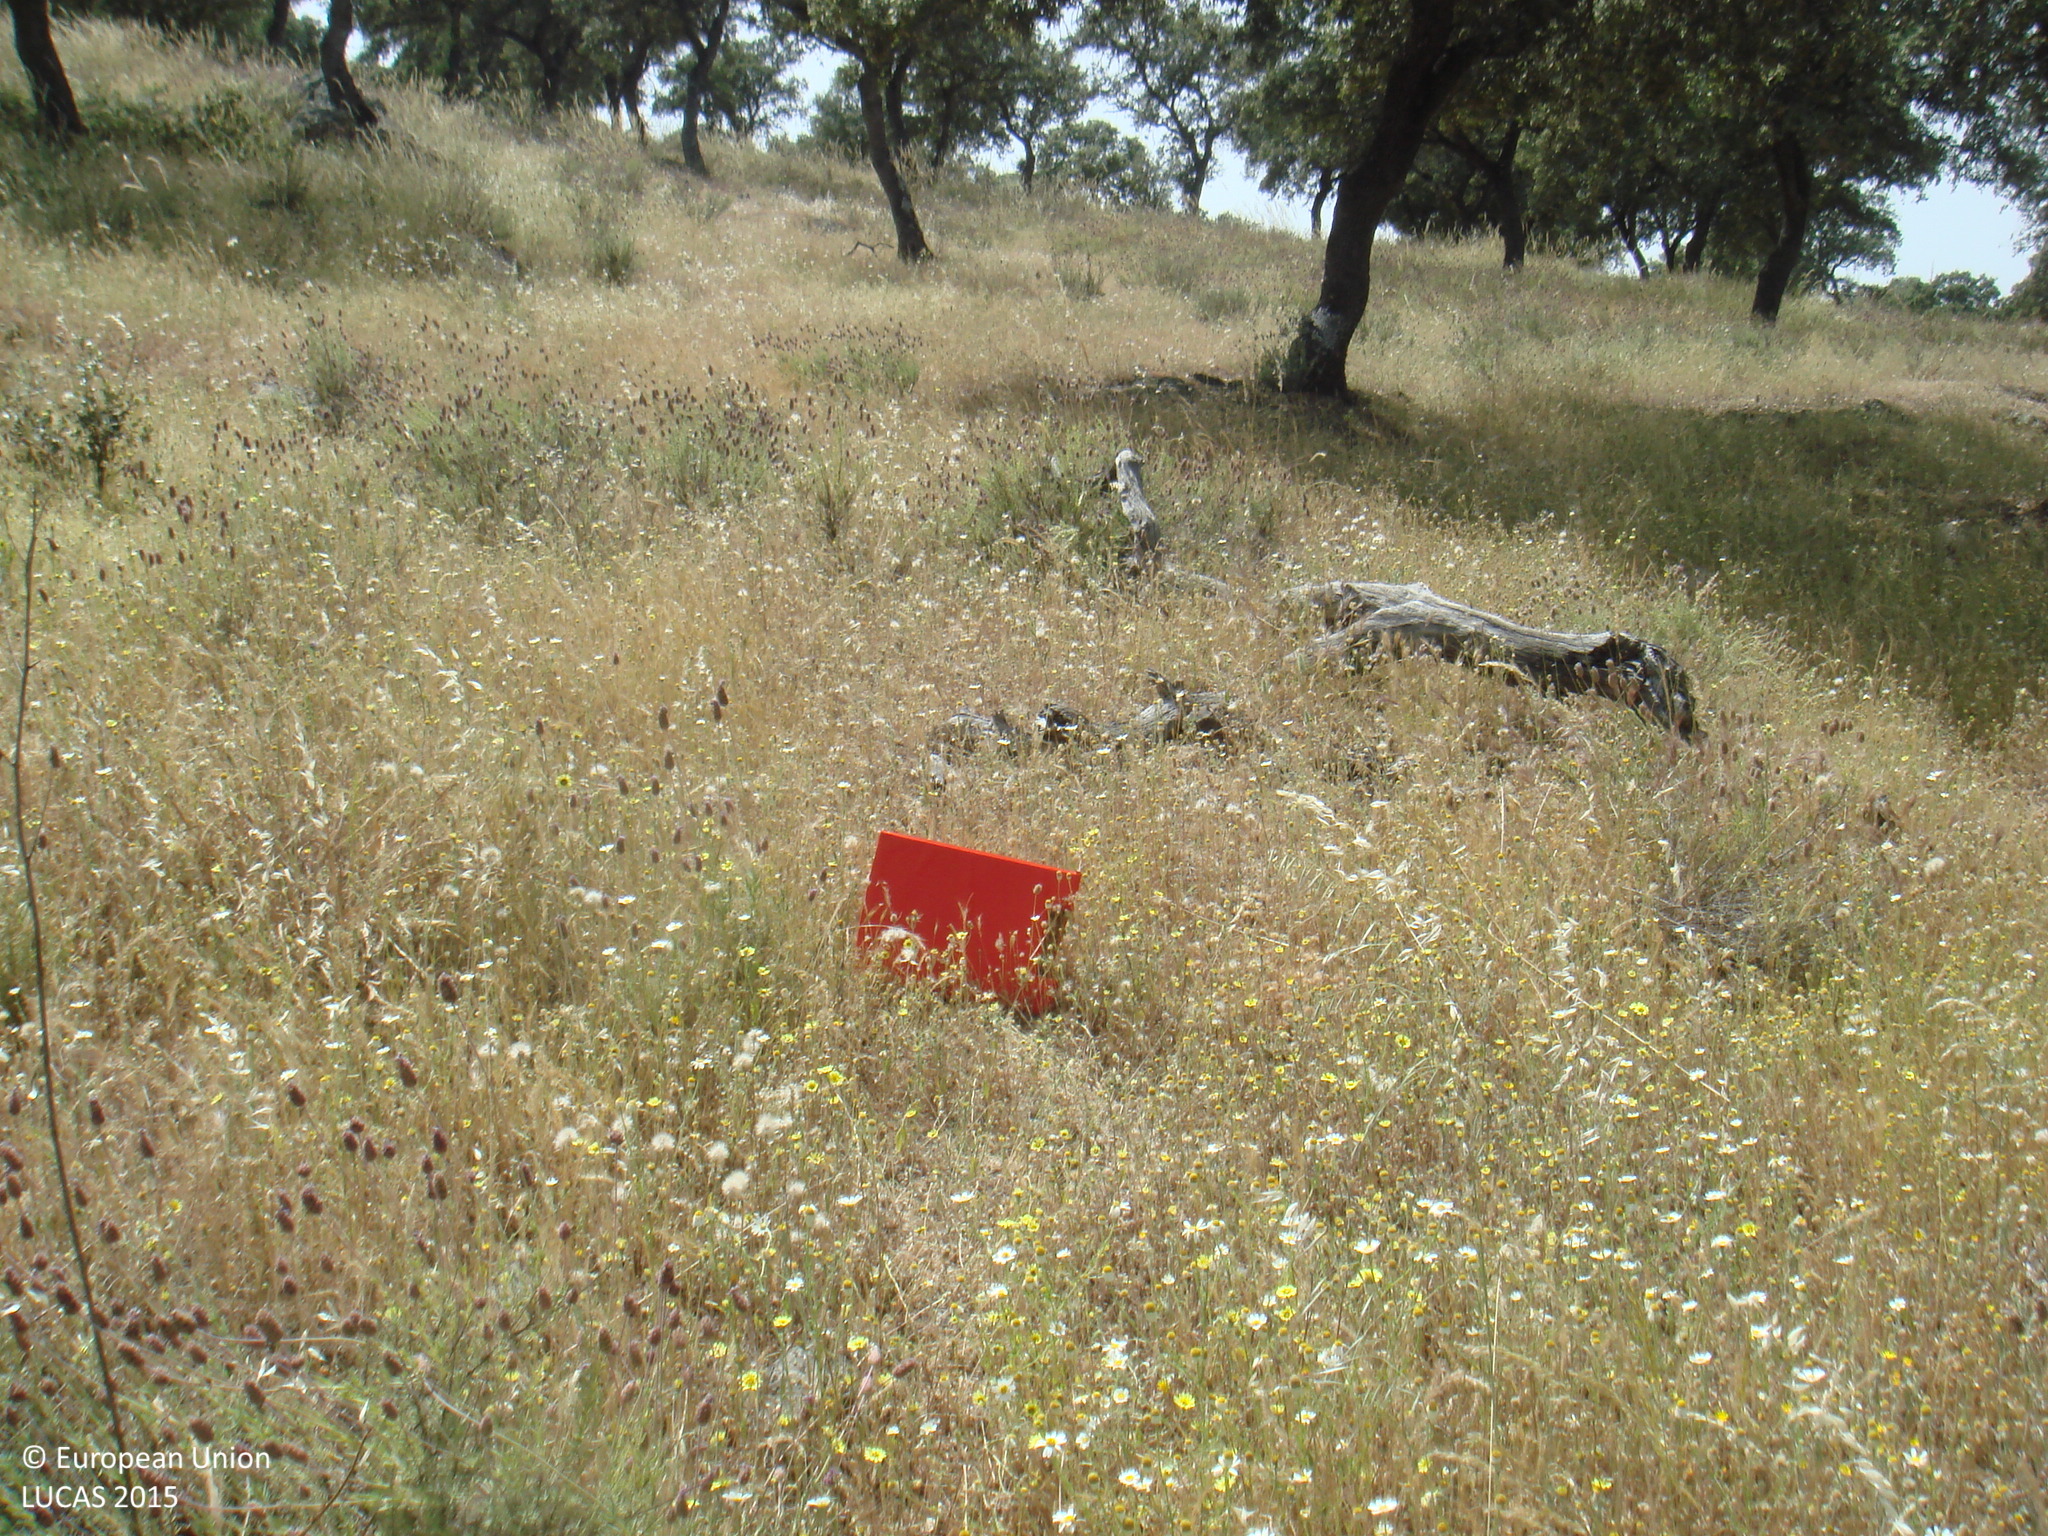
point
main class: Woodland
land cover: Broadleaved woodland
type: broadleaved evergreen forest
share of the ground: 25 - 50 %
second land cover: Spontaneously vegetated surfaces
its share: > 75 %
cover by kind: broadleaved forest trees 50 %, herbaceous plants 50 %
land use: Forestry
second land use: Agriculture (excluding fallow land and kitchen gardens)
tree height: > 5 m
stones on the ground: 10 - 25 %
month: May
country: ES
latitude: 38.5369
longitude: -4.7666
